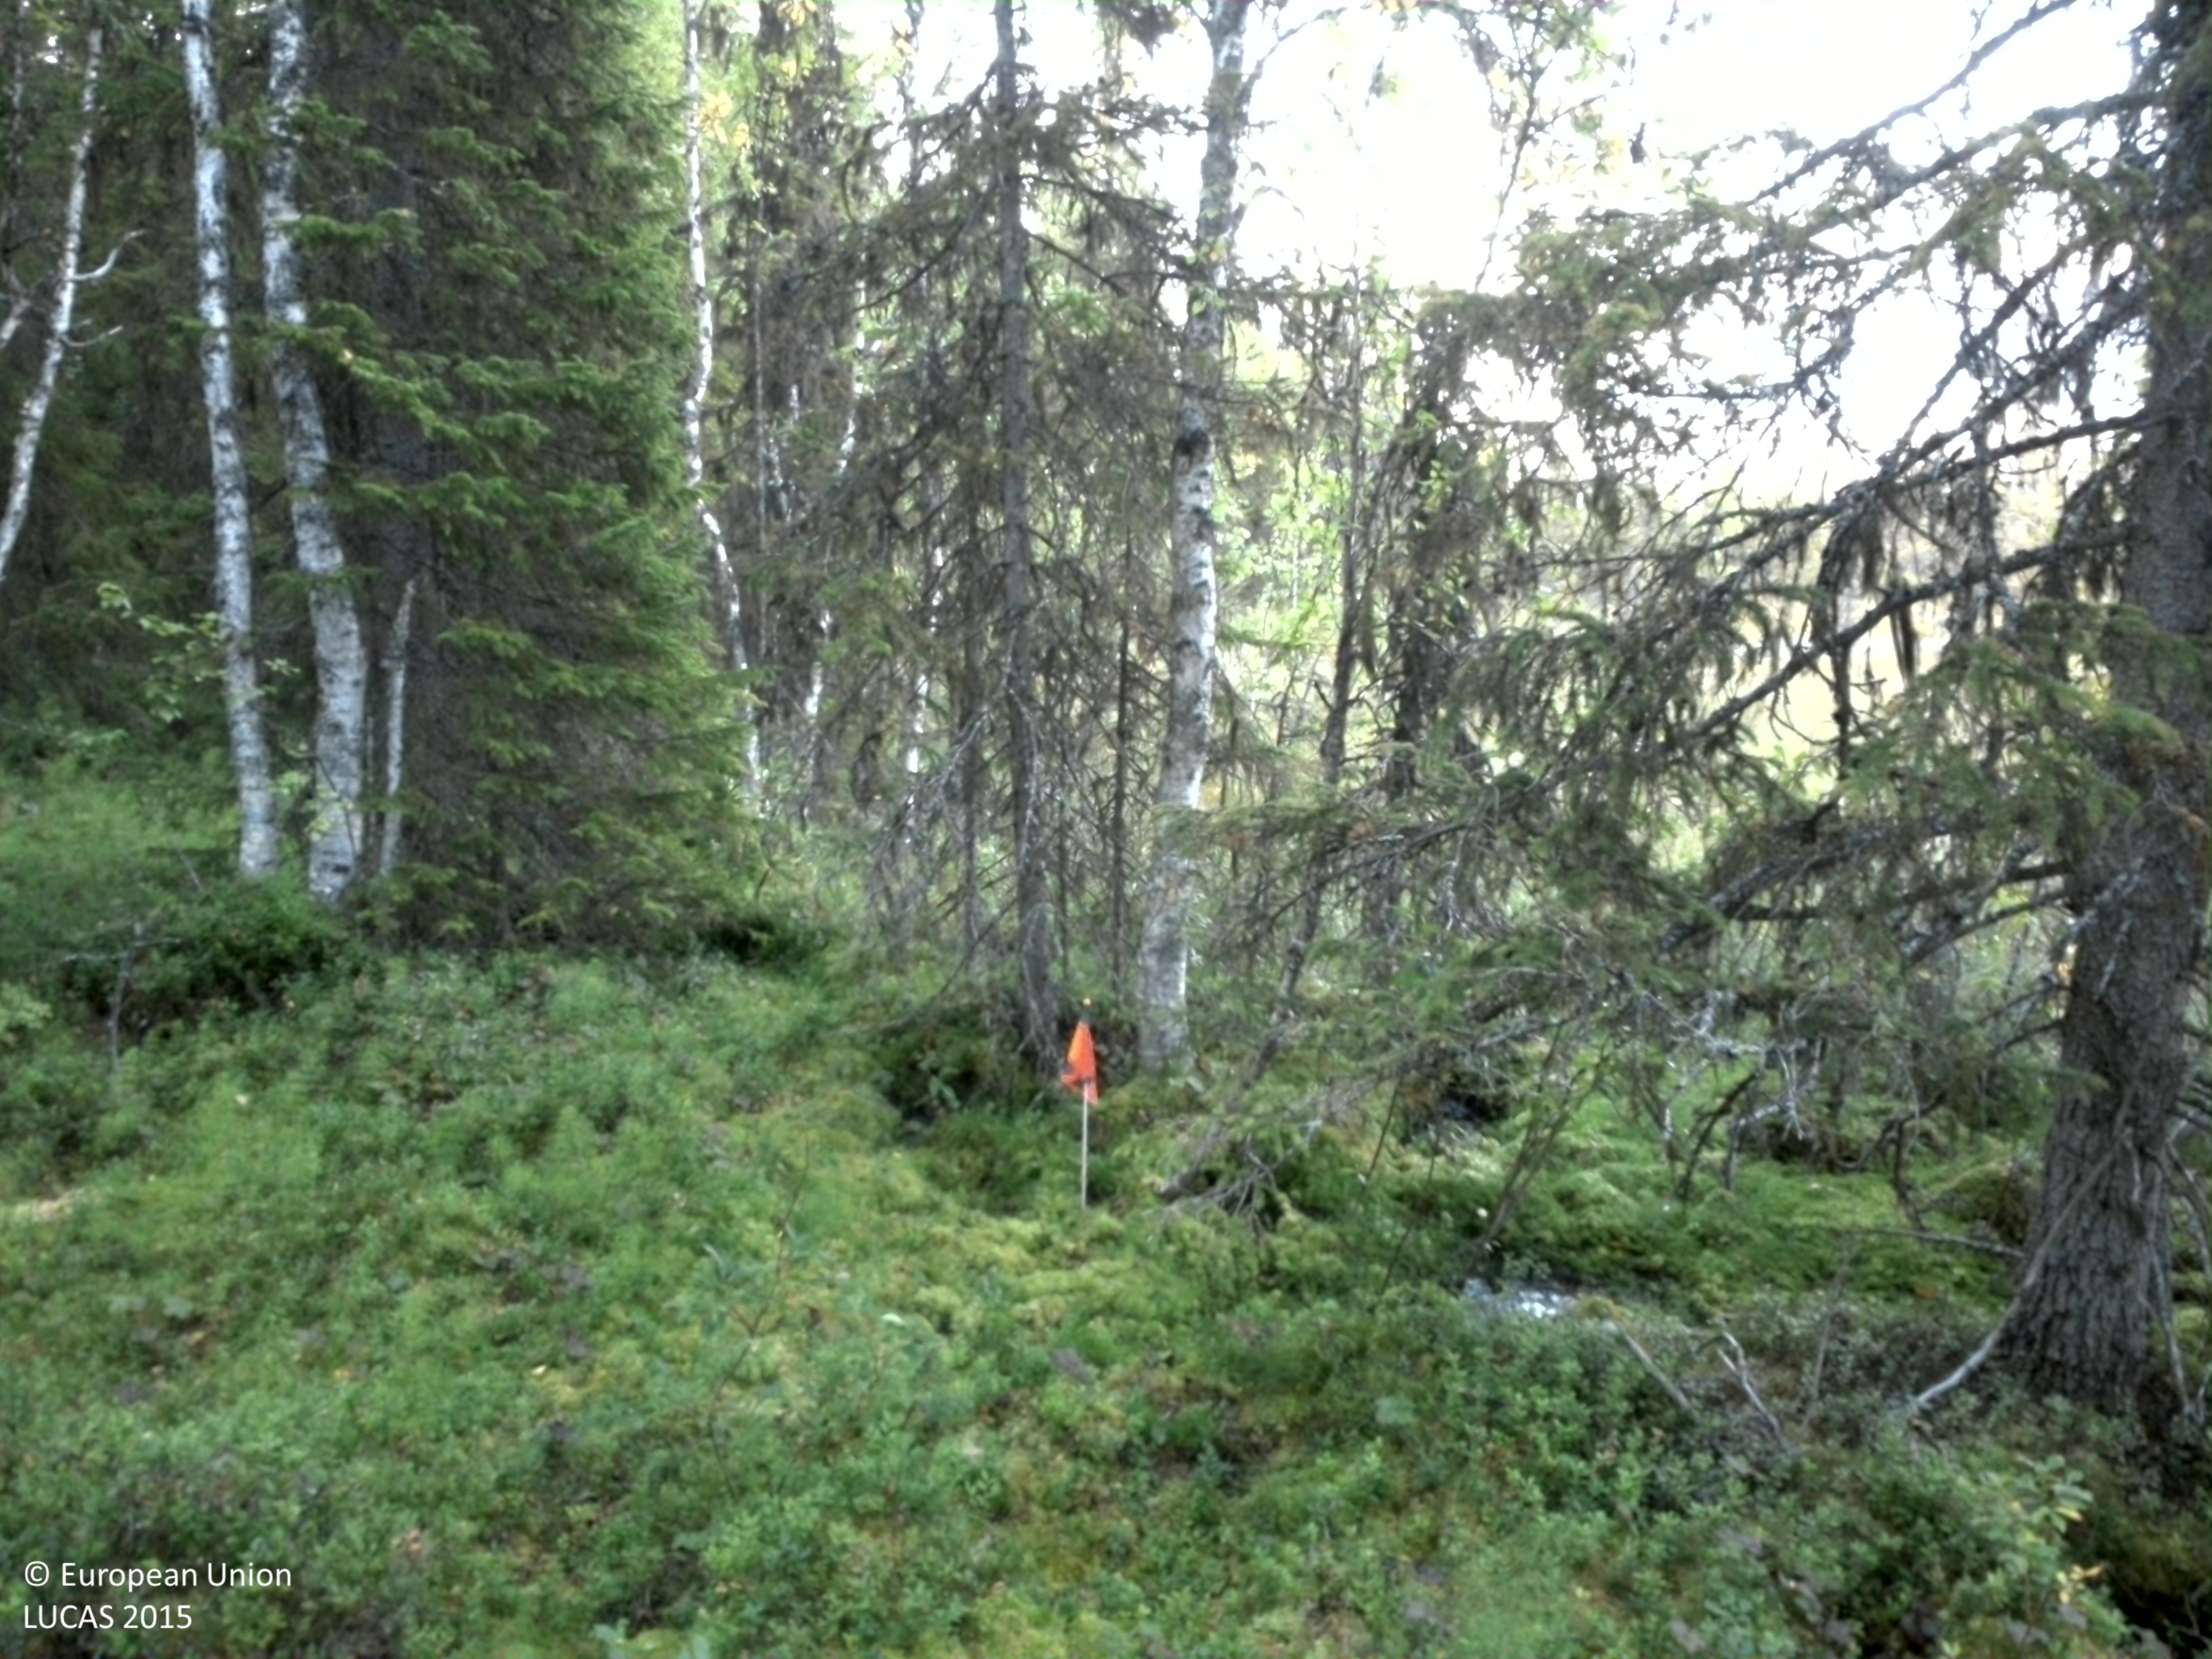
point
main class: Woodland
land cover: Spruce dominated mixed woodland
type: boreal forest
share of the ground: 25 - 50 %
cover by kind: shrubs 45 %, coniferous forest trees 20 %, lichens and mosses 20 %, broadleaved forest trees 10 %, herbaceous plants 5 %
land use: Forestry
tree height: > 5 m
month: August
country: SE
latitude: 64.7980
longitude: 16.7641
